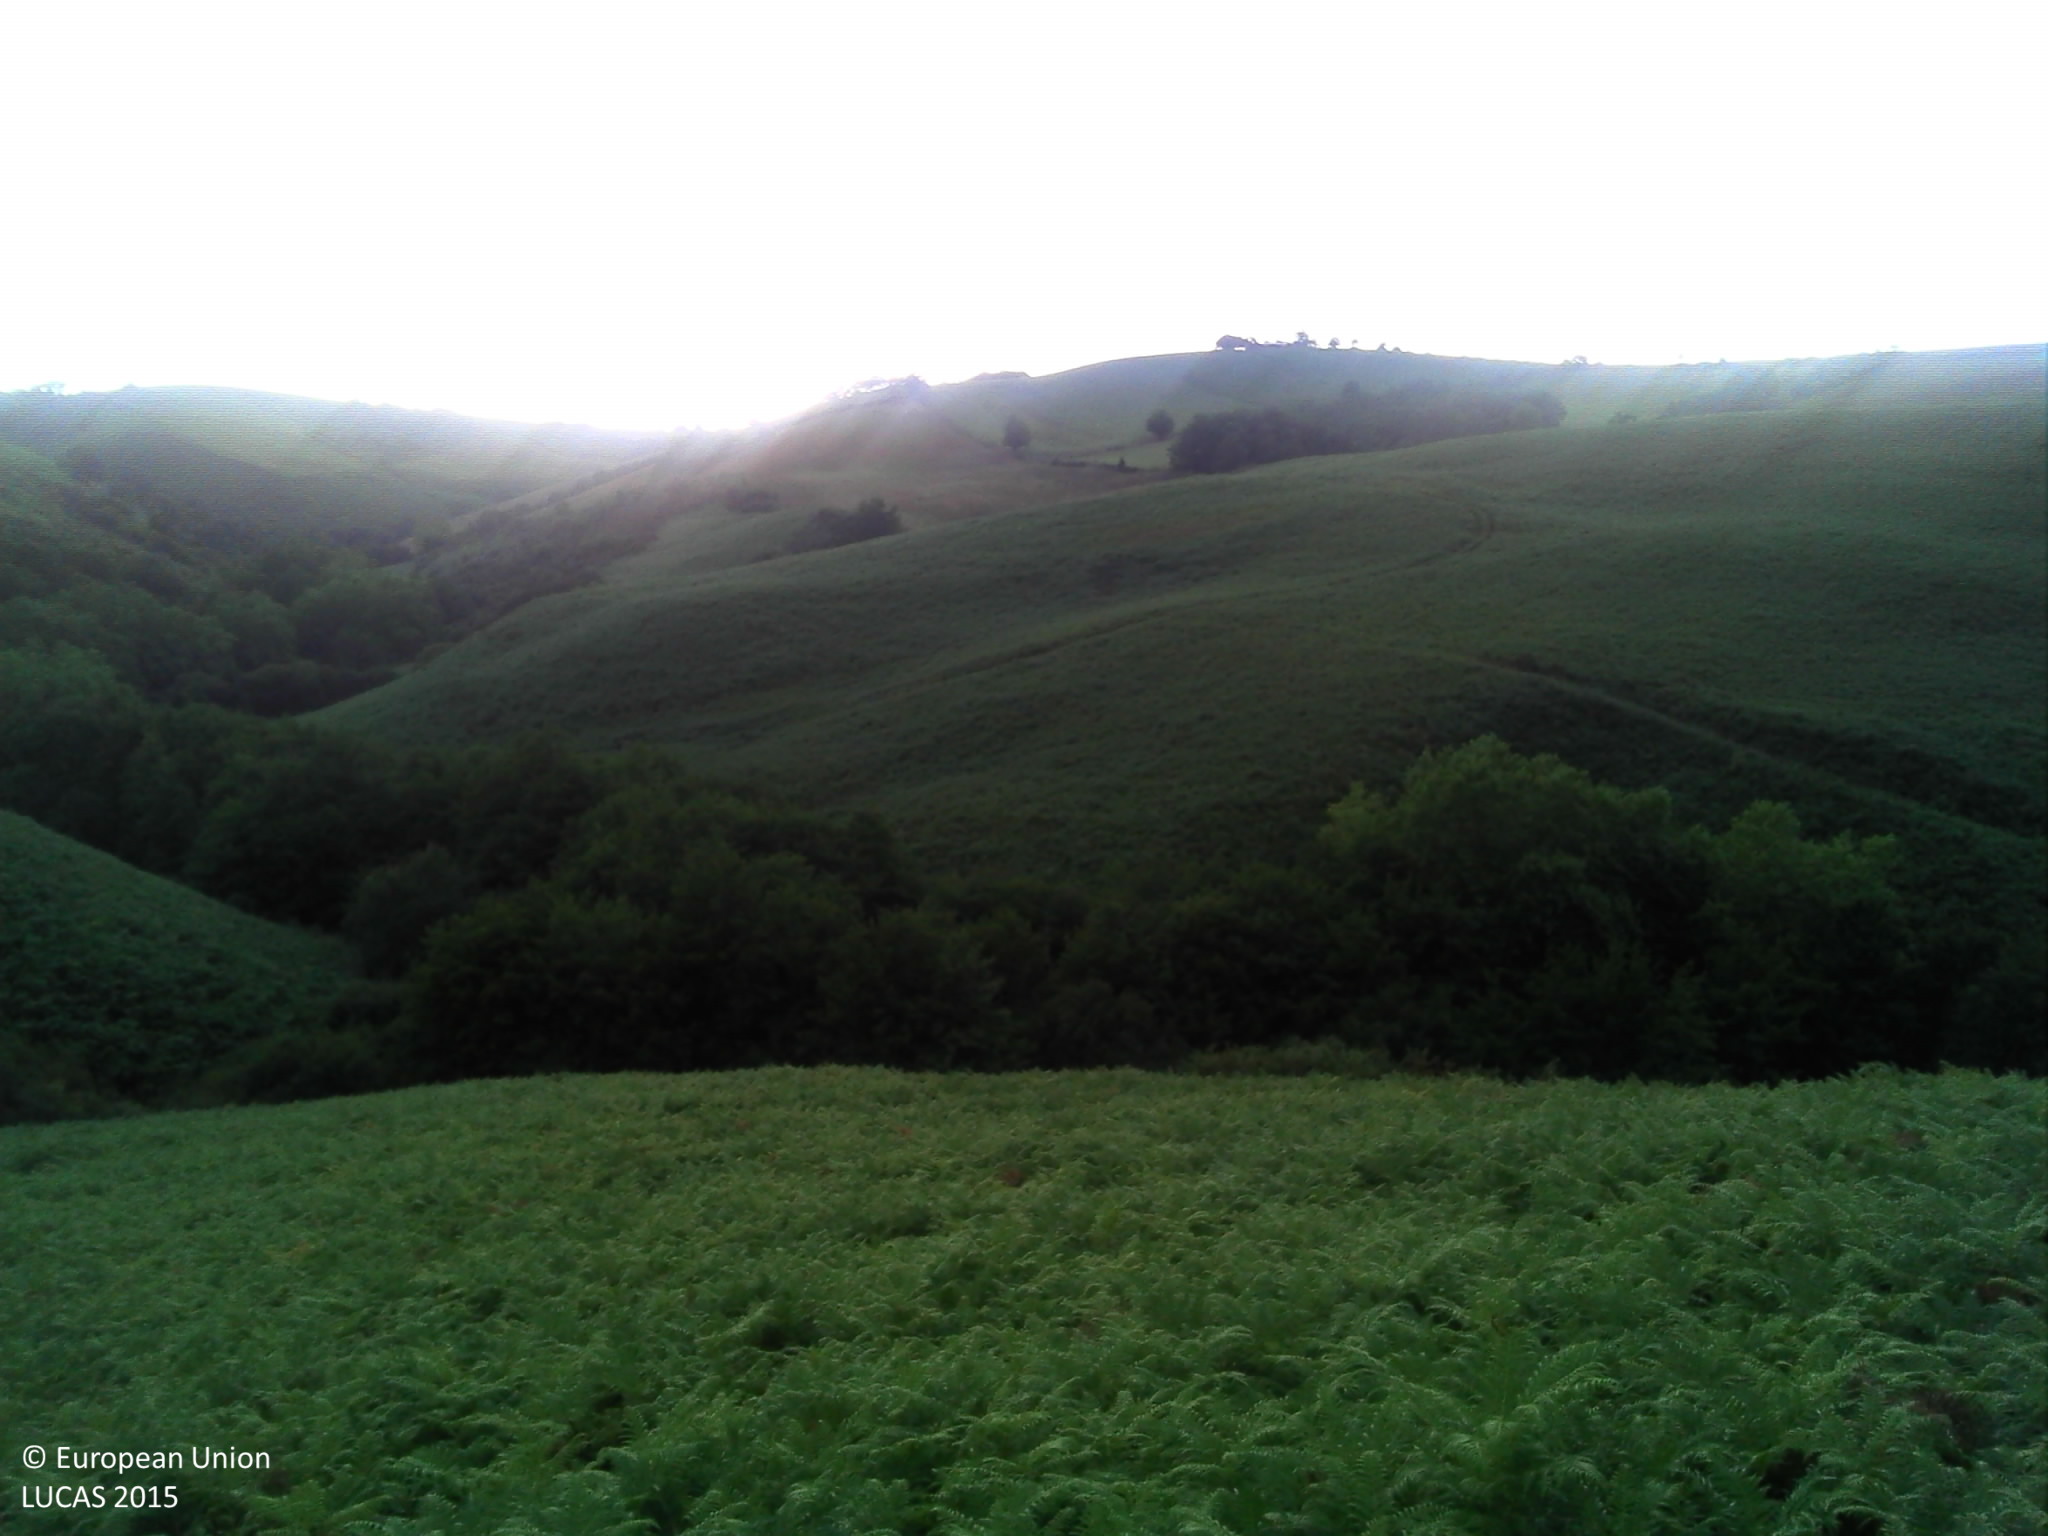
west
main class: Grassland
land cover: Grassland without tree/shrub cover
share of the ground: > 75 %
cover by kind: herbaceous plants 100 %
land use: Agriculture (excluding fallow land and kitchen gardens)
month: August
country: FR
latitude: 43.3799
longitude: -1.1850
